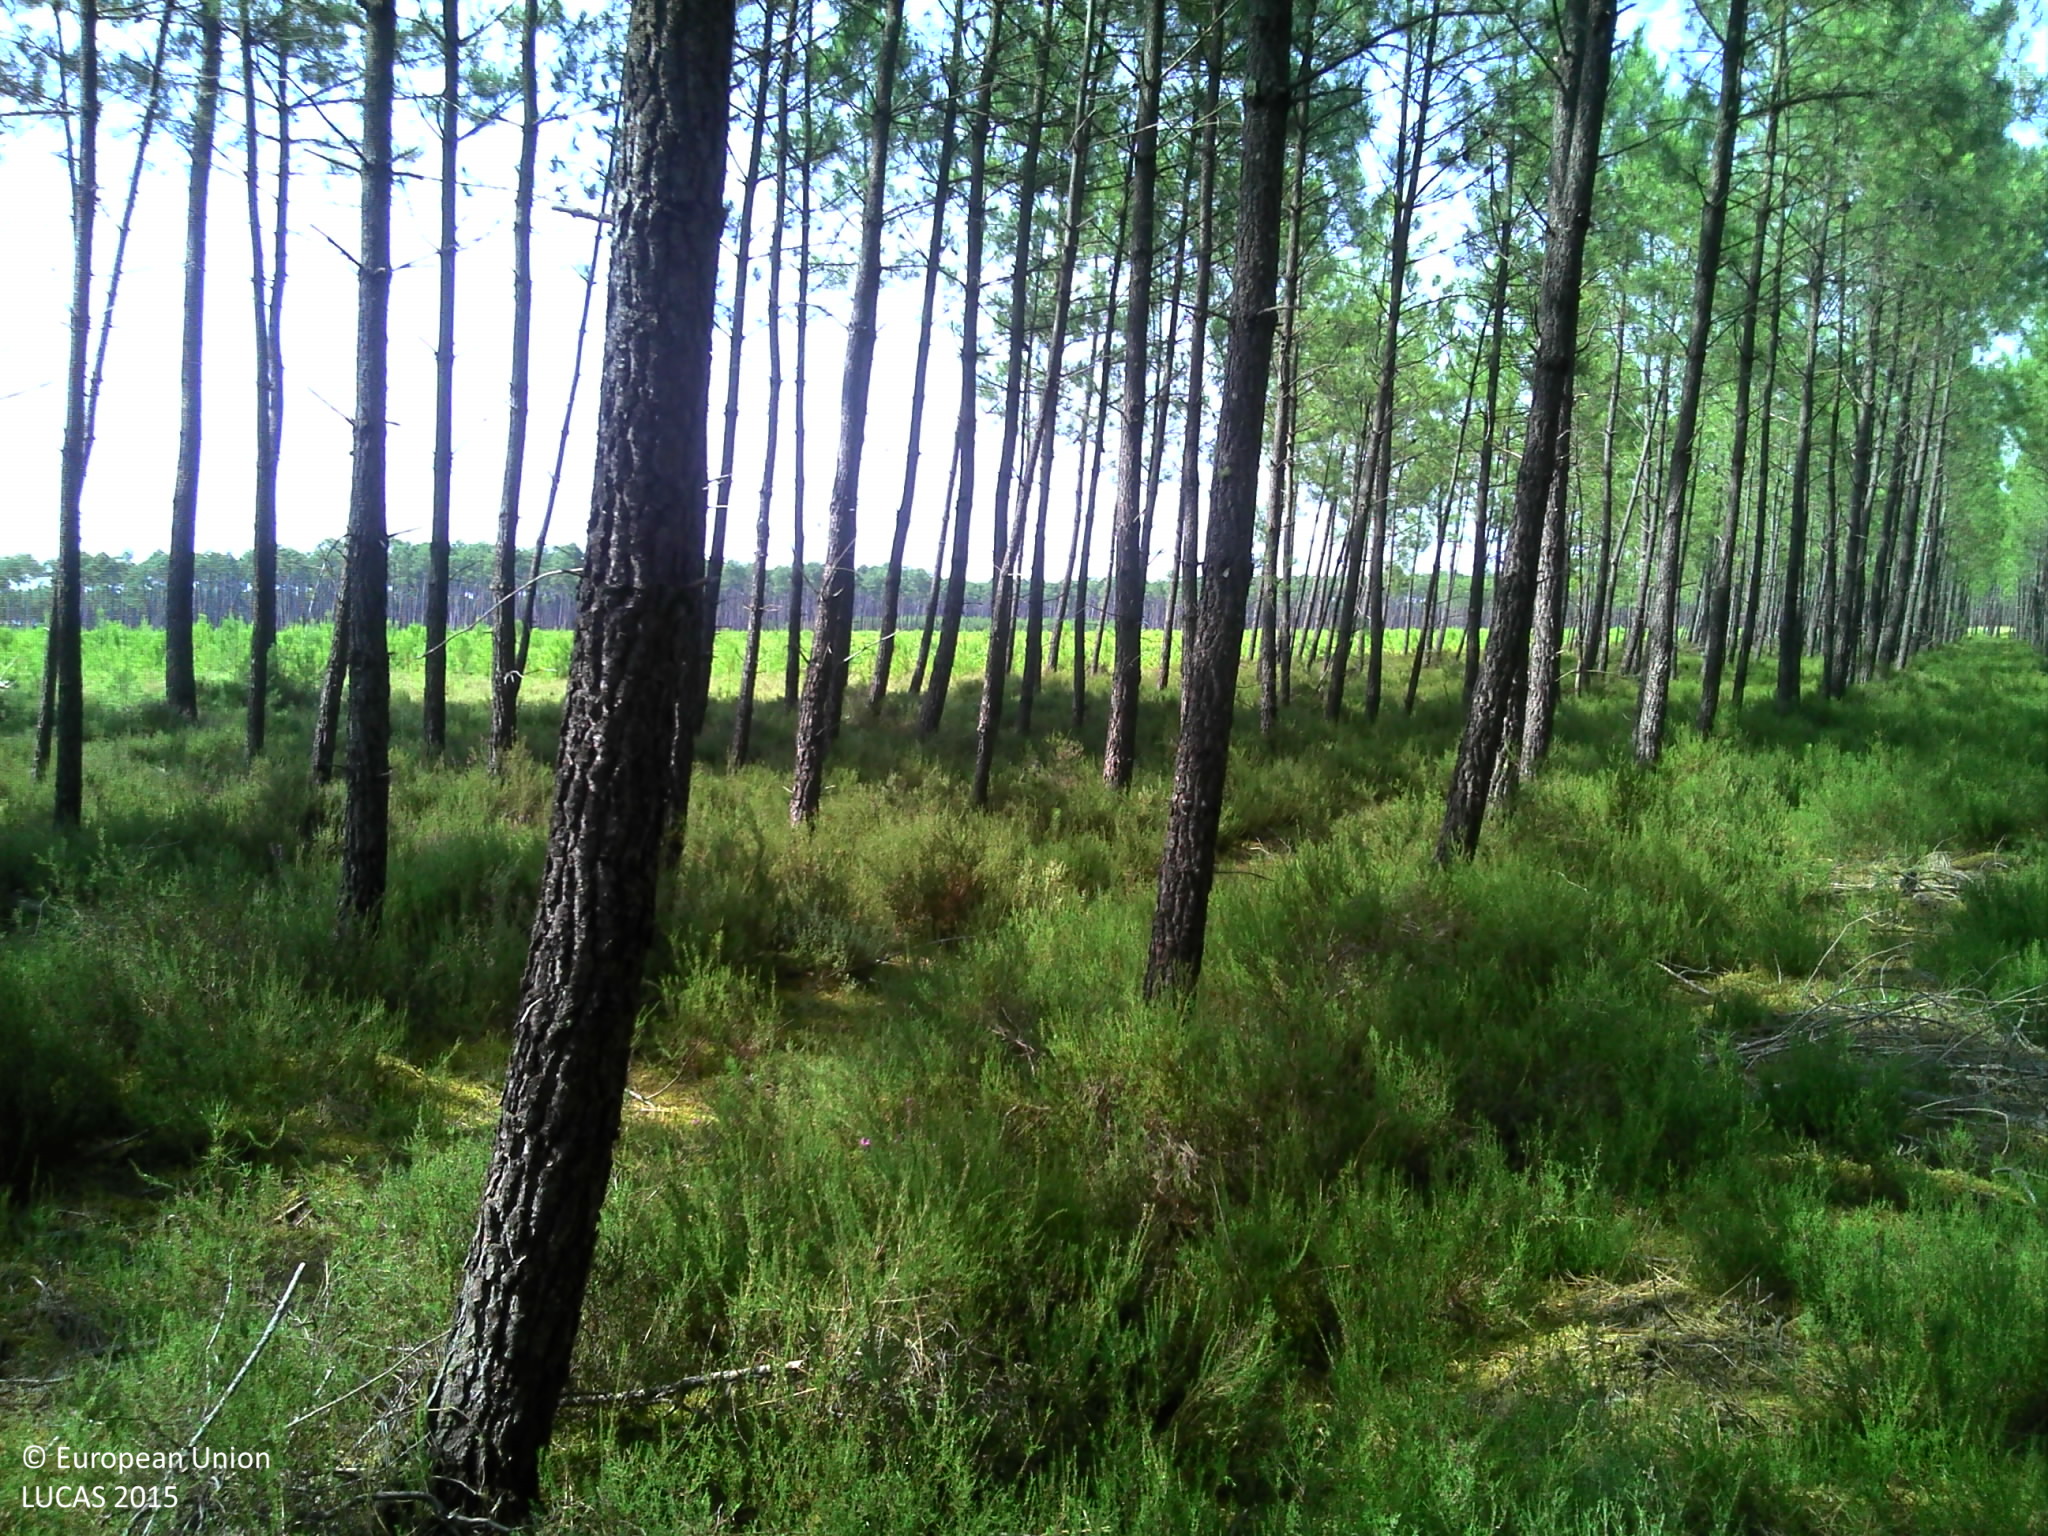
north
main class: Woodland
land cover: Pine dominated coniferous woodland
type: coniferous forest of the mediterranean region
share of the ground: > 75 %
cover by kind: coniferous forest trees 80 %, herbaceous plants 10 %, broadleaved forest trees 5 %, lichens and mosses 5 %
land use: Forestry
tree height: > 5 m
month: July
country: FR
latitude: 43.8130
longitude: -1.2192
